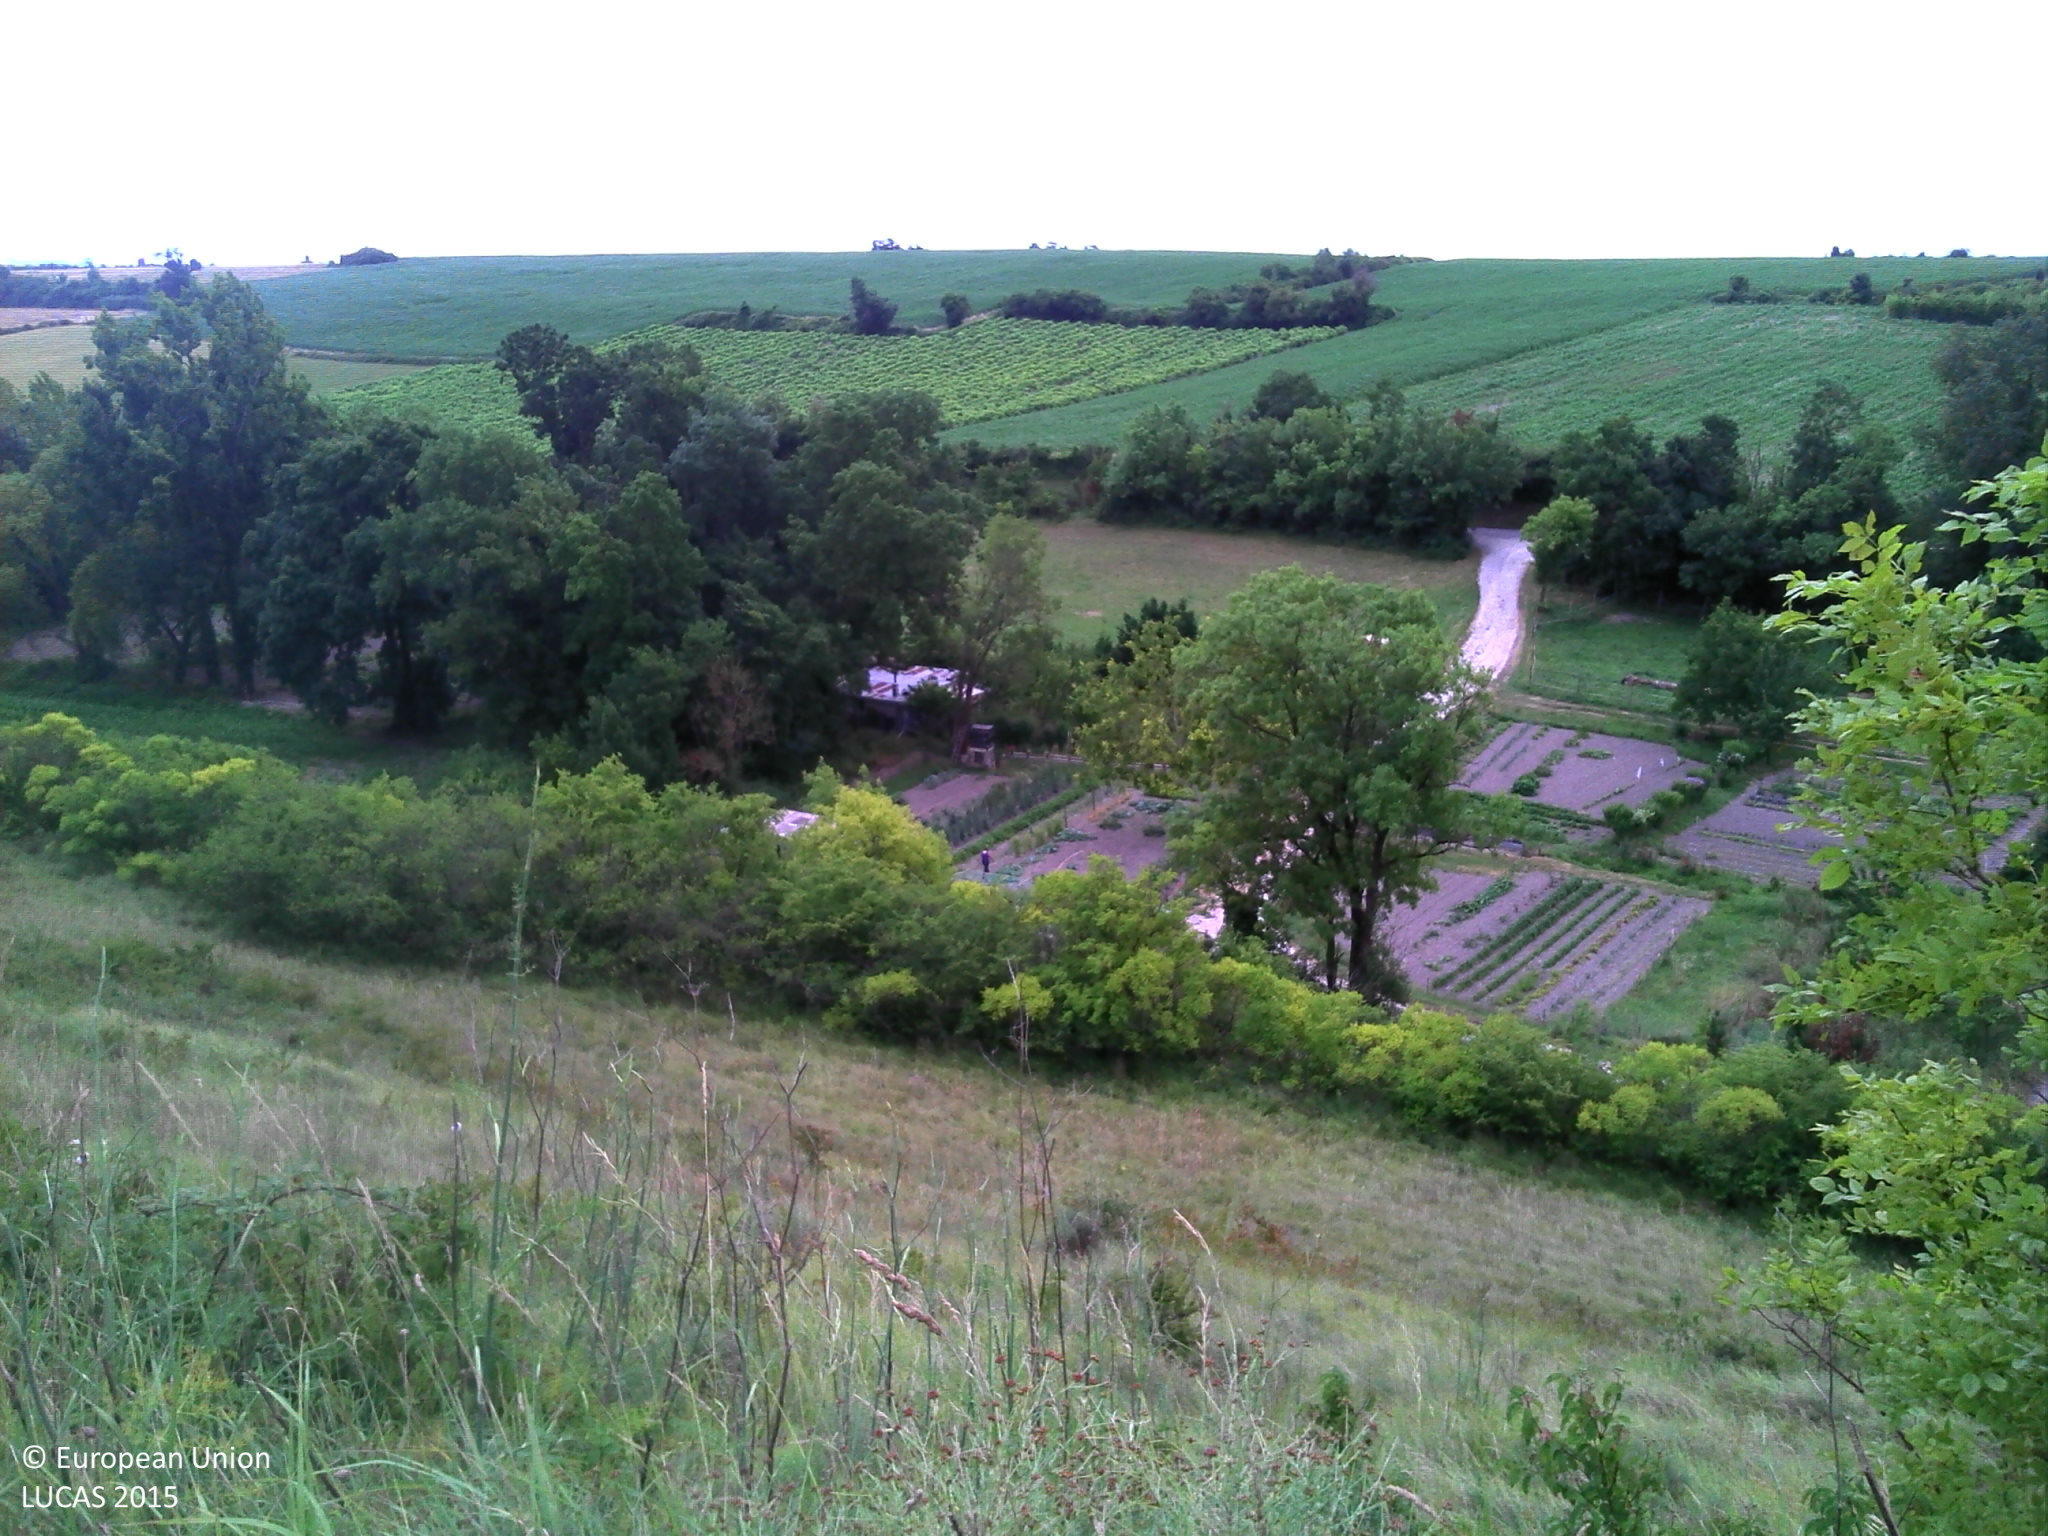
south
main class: Shrubland
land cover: Shrubland without tree cover
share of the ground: > 75 %
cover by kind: shrubs 100 %
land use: Sport
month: July
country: FR
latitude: 45.4775
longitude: -0.7828
